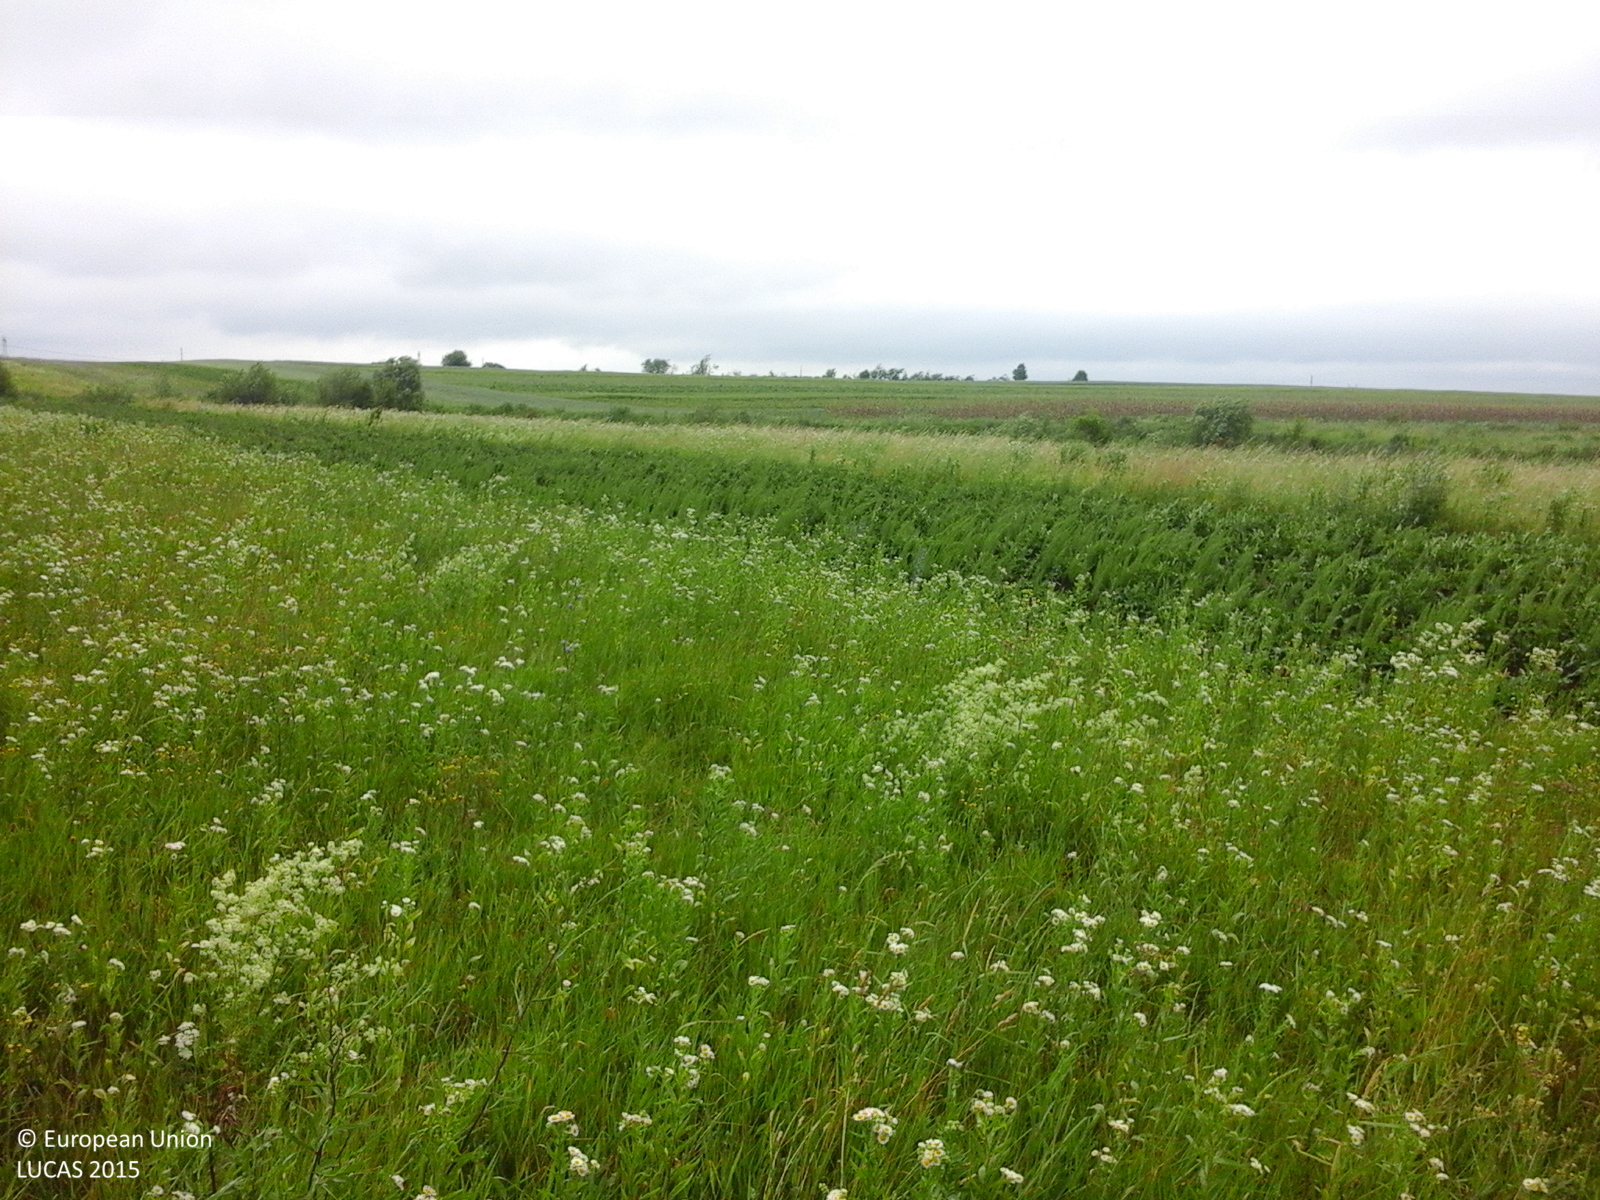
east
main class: Grassland
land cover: Grassland without tree/shrub cover
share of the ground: > 75 %
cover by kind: herbaceous plants 100 %
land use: Agriculture (excluding fallow land and kitchen gardens)
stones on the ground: < 10 %
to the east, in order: Grassland without tree/shrub cover; Potatoes; Grassland without tree/shrub cover; Spontaneously vegetated surfaces; Abandoned hedges; Ditches and canals; Spontaneously vegetated surfaces; Ditches and canals; Spontaneously vegetated surfaces; Maize; Soya; Maize; Grassland without tree/shrub cover; Maize; Soya
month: June
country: RO
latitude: 47.4264
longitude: 26.2686
